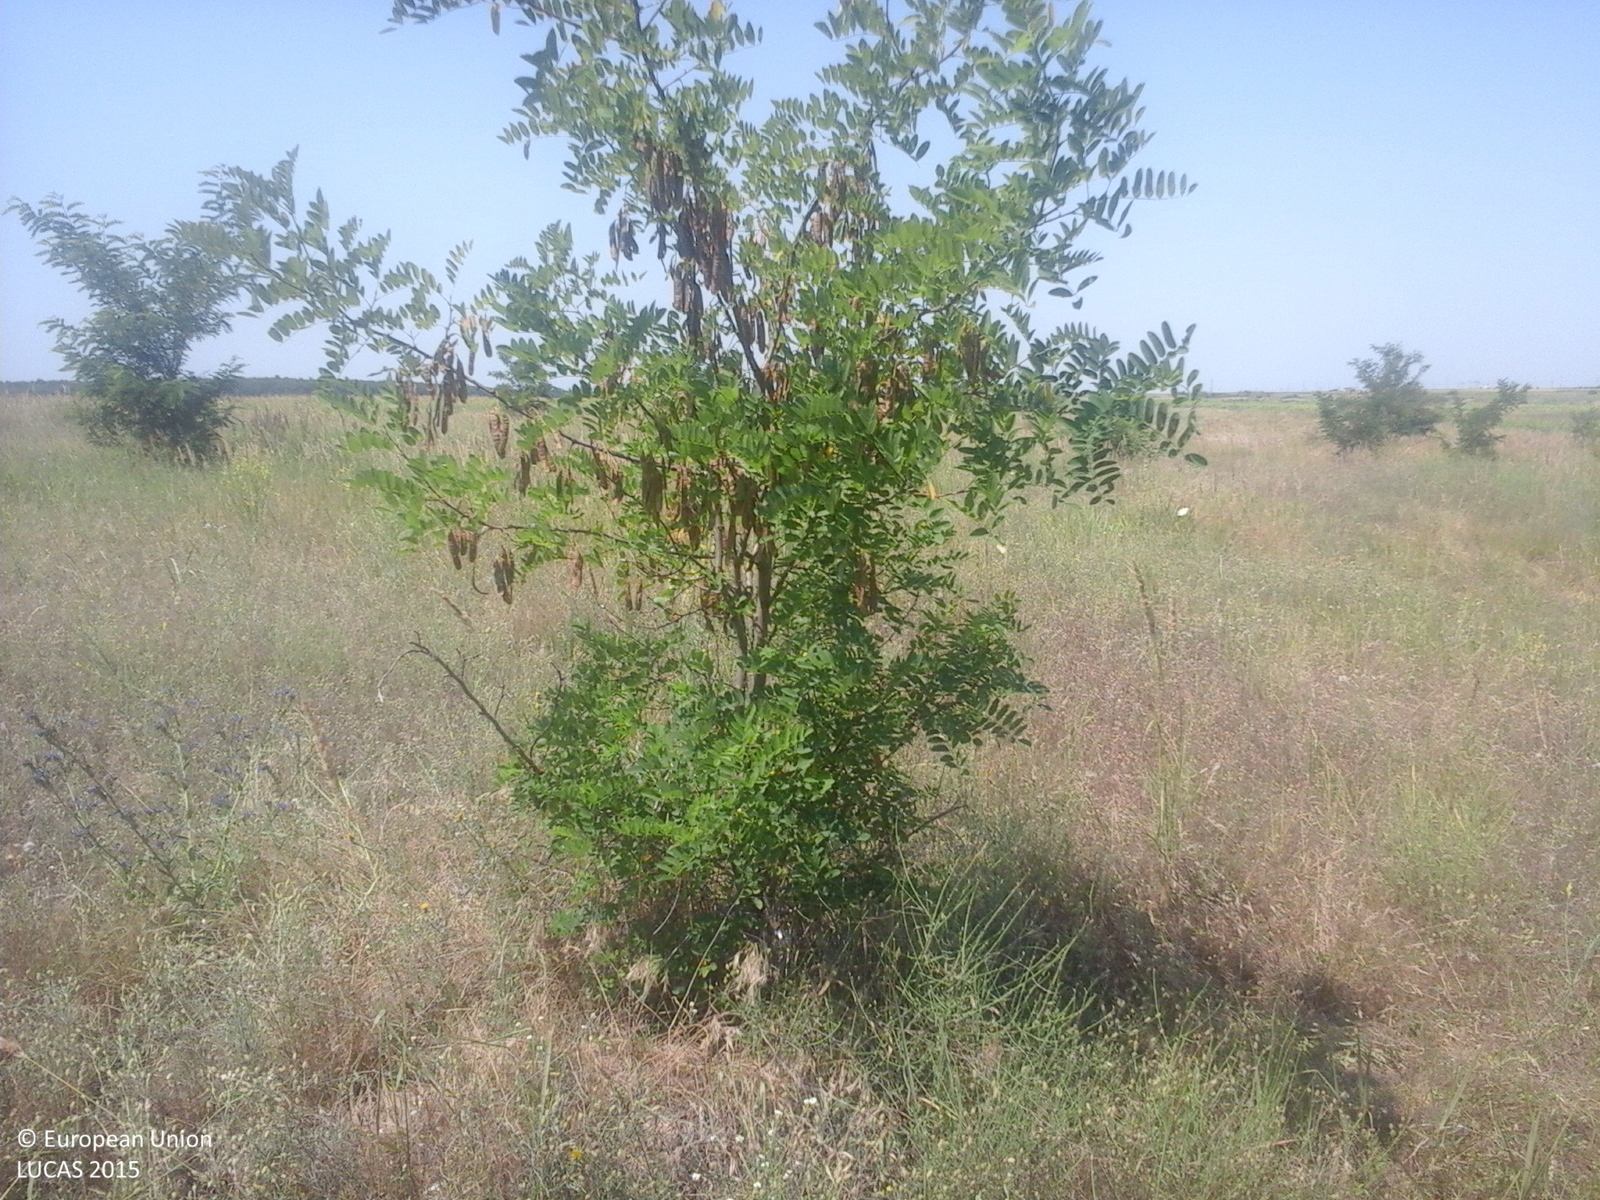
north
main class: Grassland
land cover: Grassland with sparse tree/shrub cover
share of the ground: > 75 %
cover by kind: herbaceous plants 85 %, shrubs 10 %, broadleaved forest trees 5 %
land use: Agriculture (excluding fallow land and kitchen gardens)
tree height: < 5 m
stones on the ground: < 10 %
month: July
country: RO
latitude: 44.8589
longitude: 27.7052
